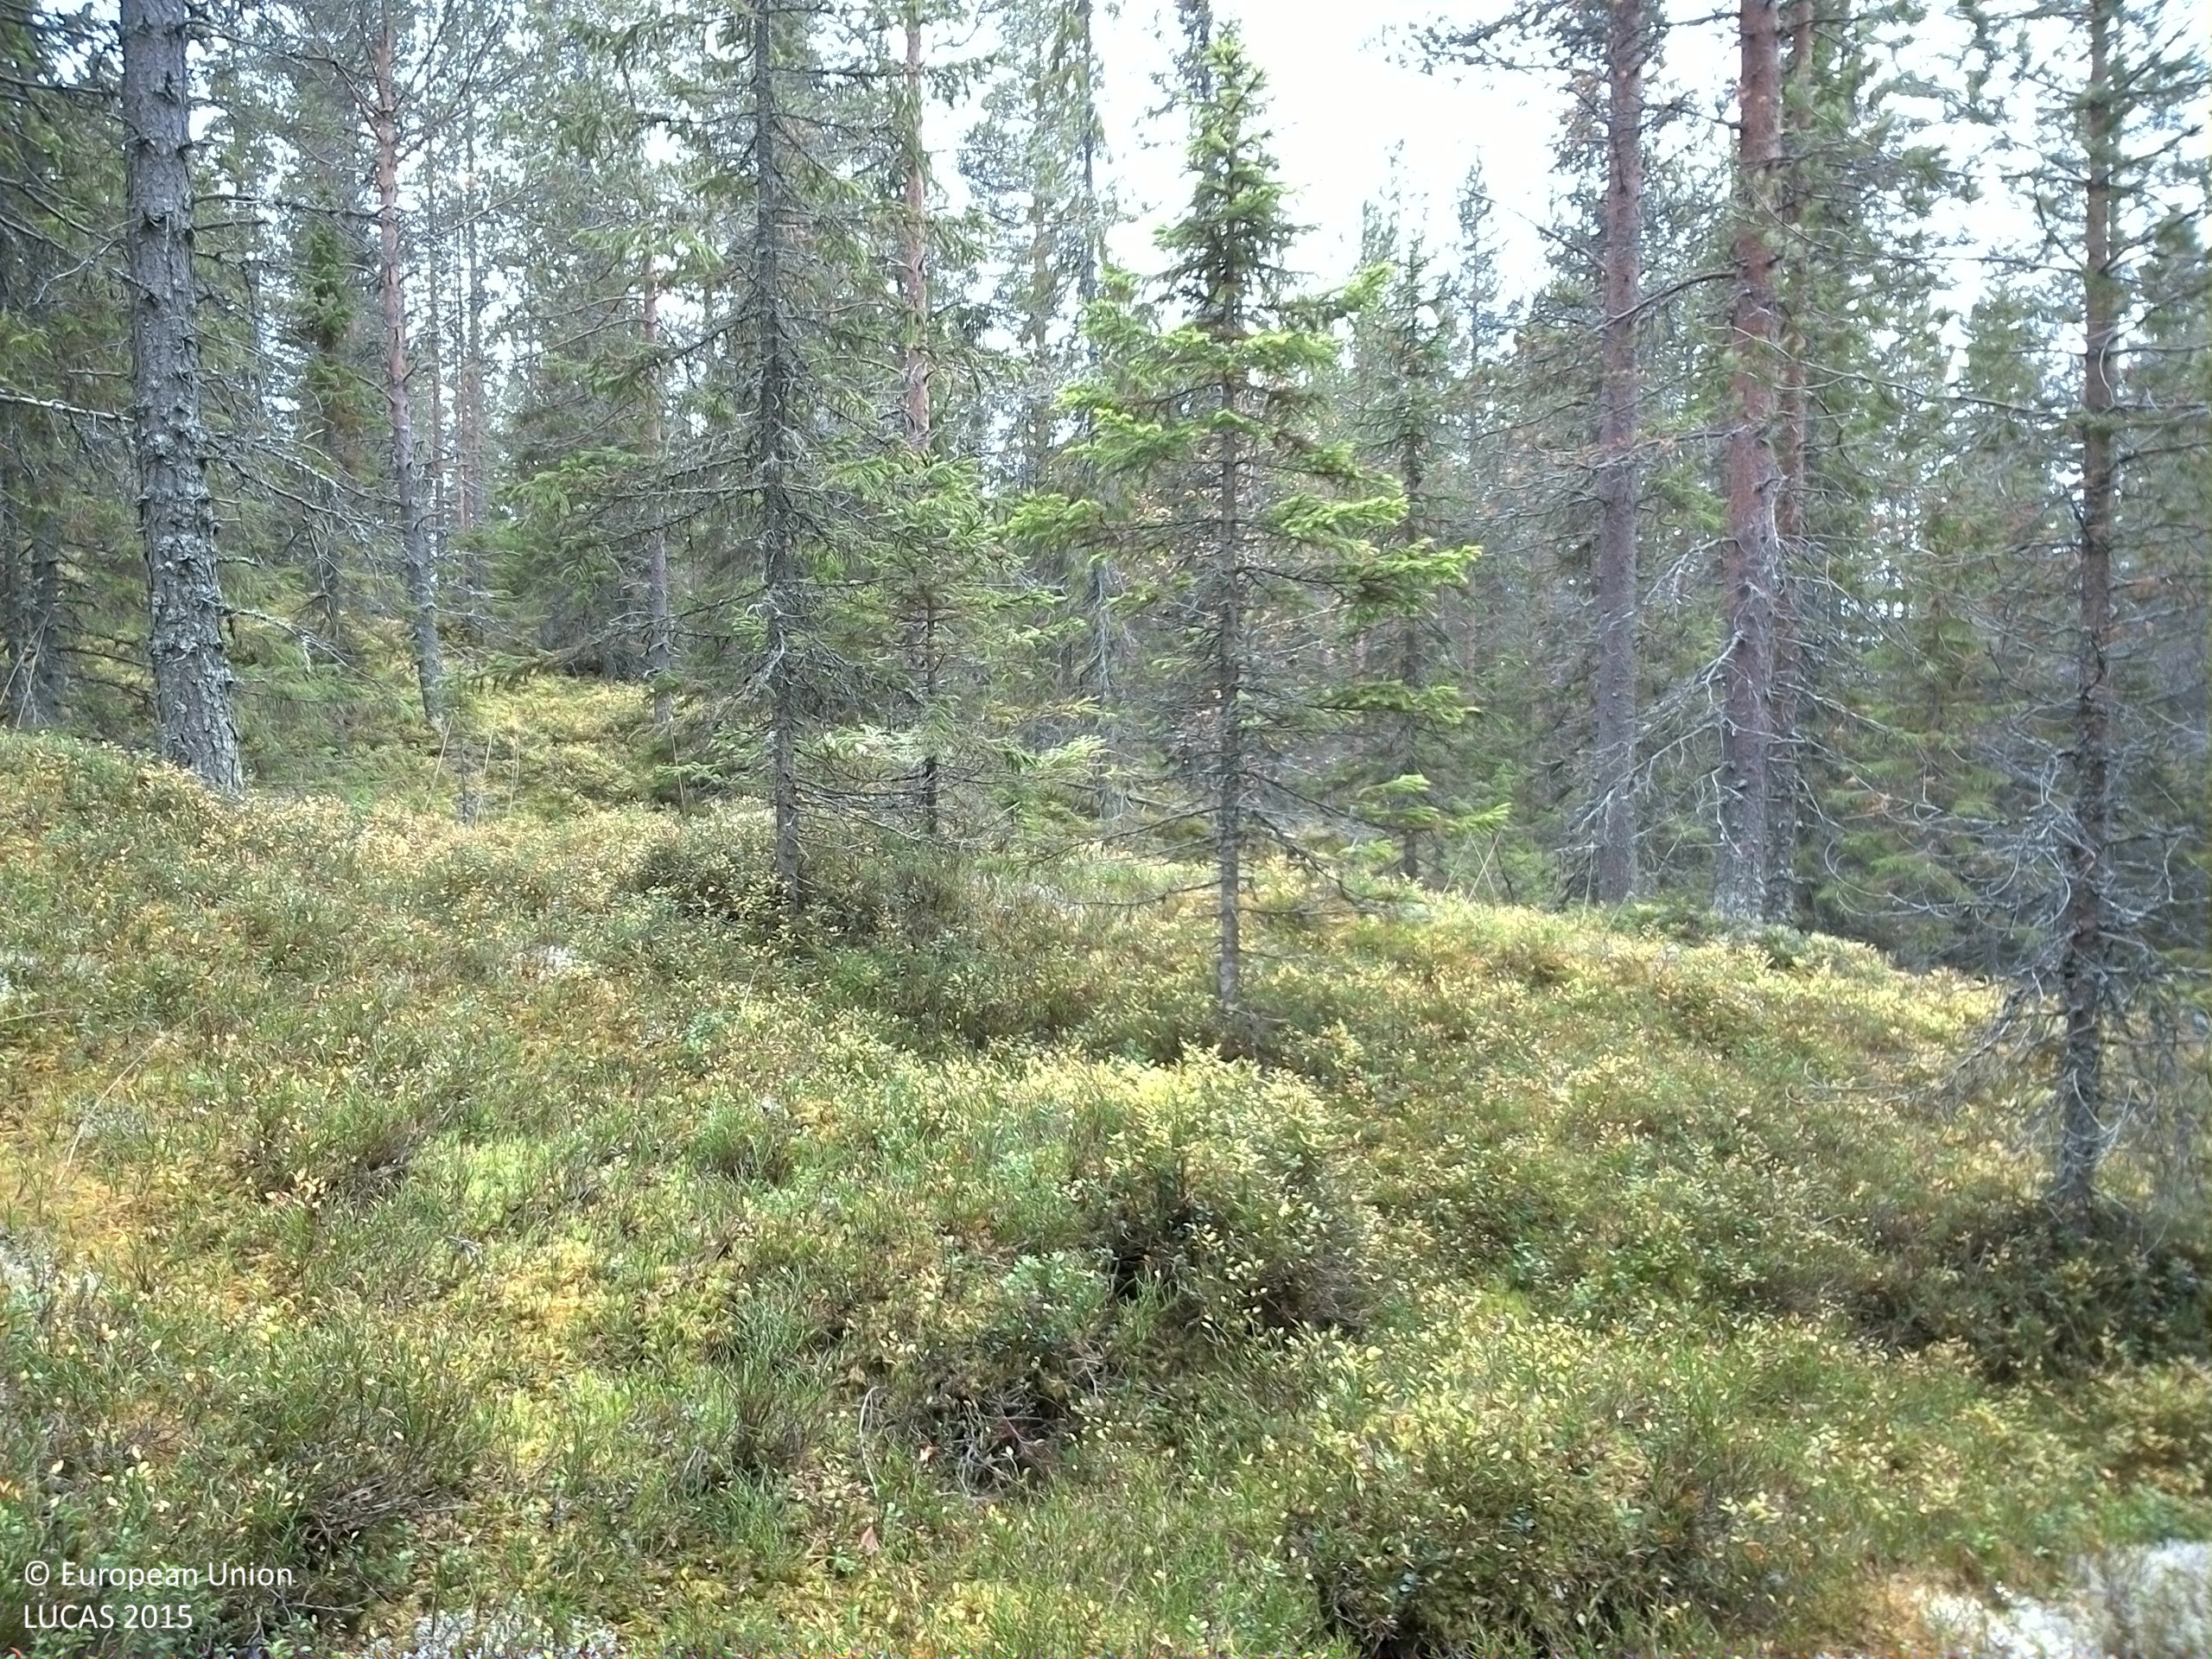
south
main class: Woodland
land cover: Spruce dominated coniferous woodland
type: boreal forest
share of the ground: 25 - 50 %
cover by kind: coniferous forest trees 45 %, shrubs 30 %, lichens and mosses 15 %, consolidated bare surface 10 %
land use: Forestry
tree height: > 5 m
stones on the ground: 10 - 25 %
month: October
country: SE
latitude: 61.5370
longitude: 14.4053
